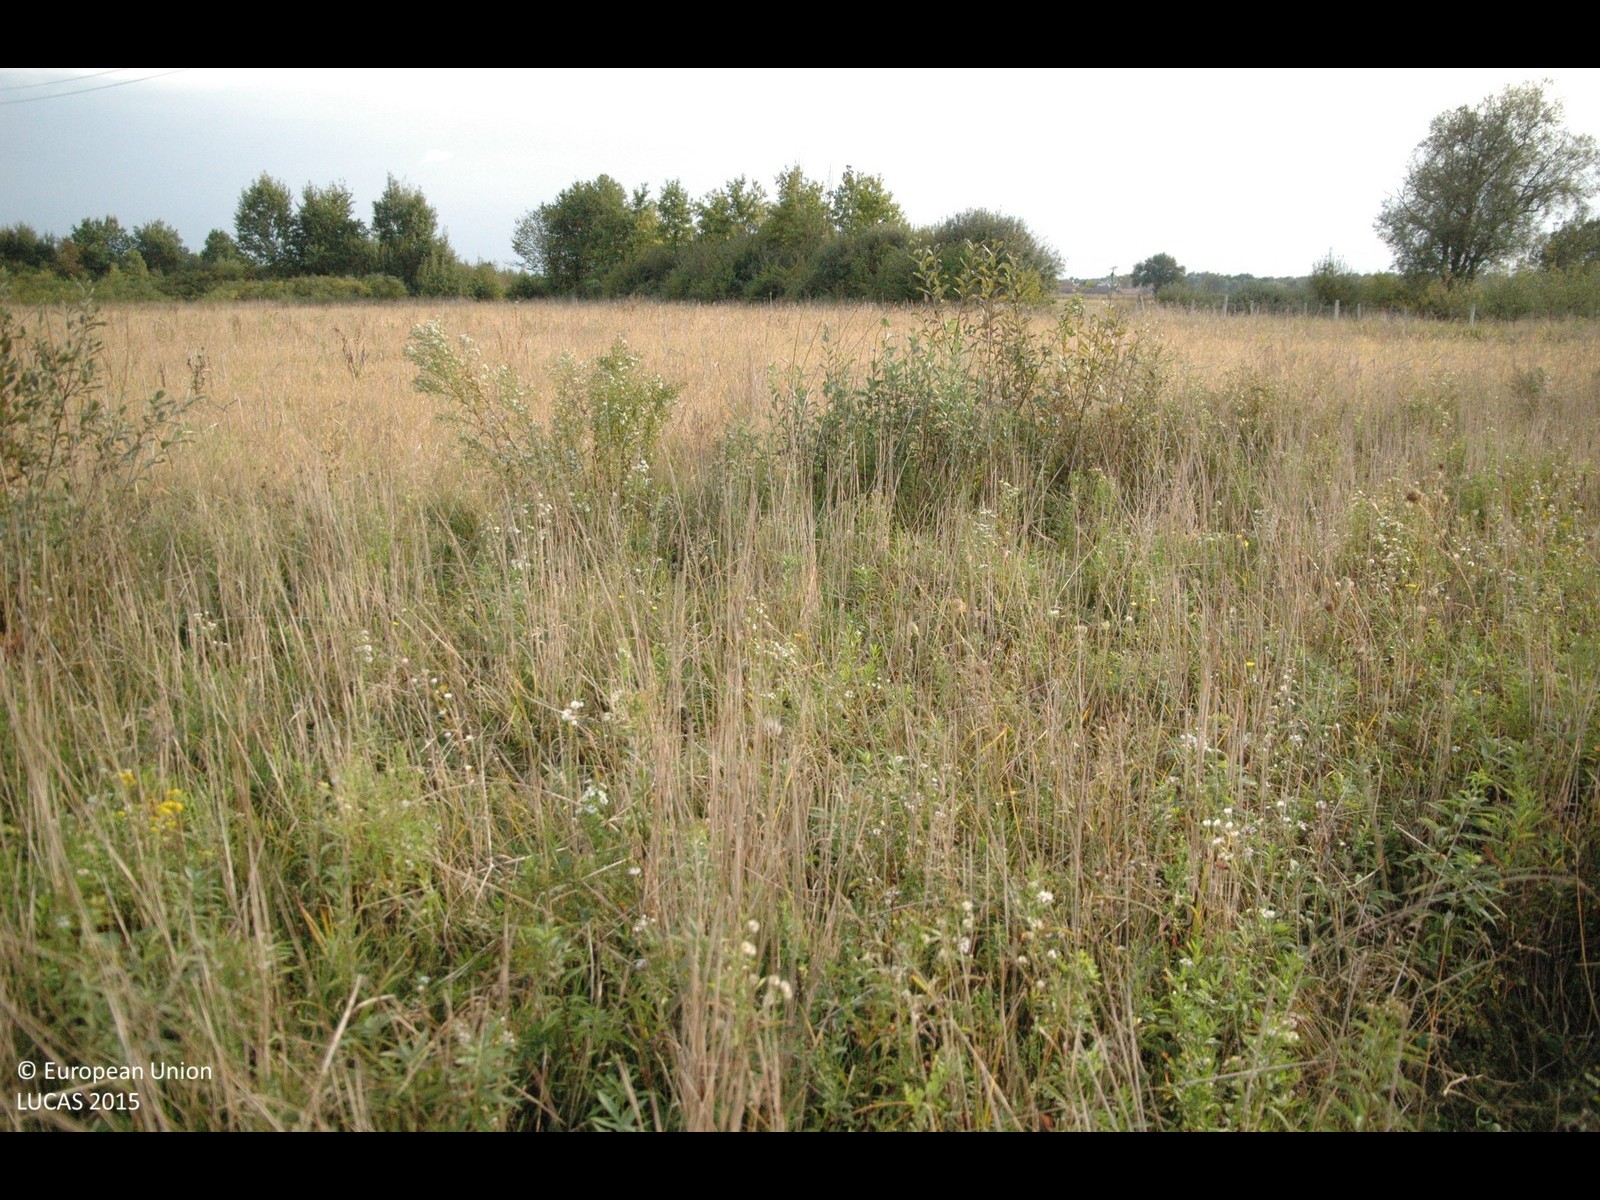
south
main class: Grassland
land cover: Grassland without tree/shrub cover
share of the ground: > 75 %
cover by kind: herbaceous plants 100 %
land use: Agriculture (excluding fallow land and kitchen gardens)
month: October
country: HR
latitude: 45.5549
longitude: 16.2362
